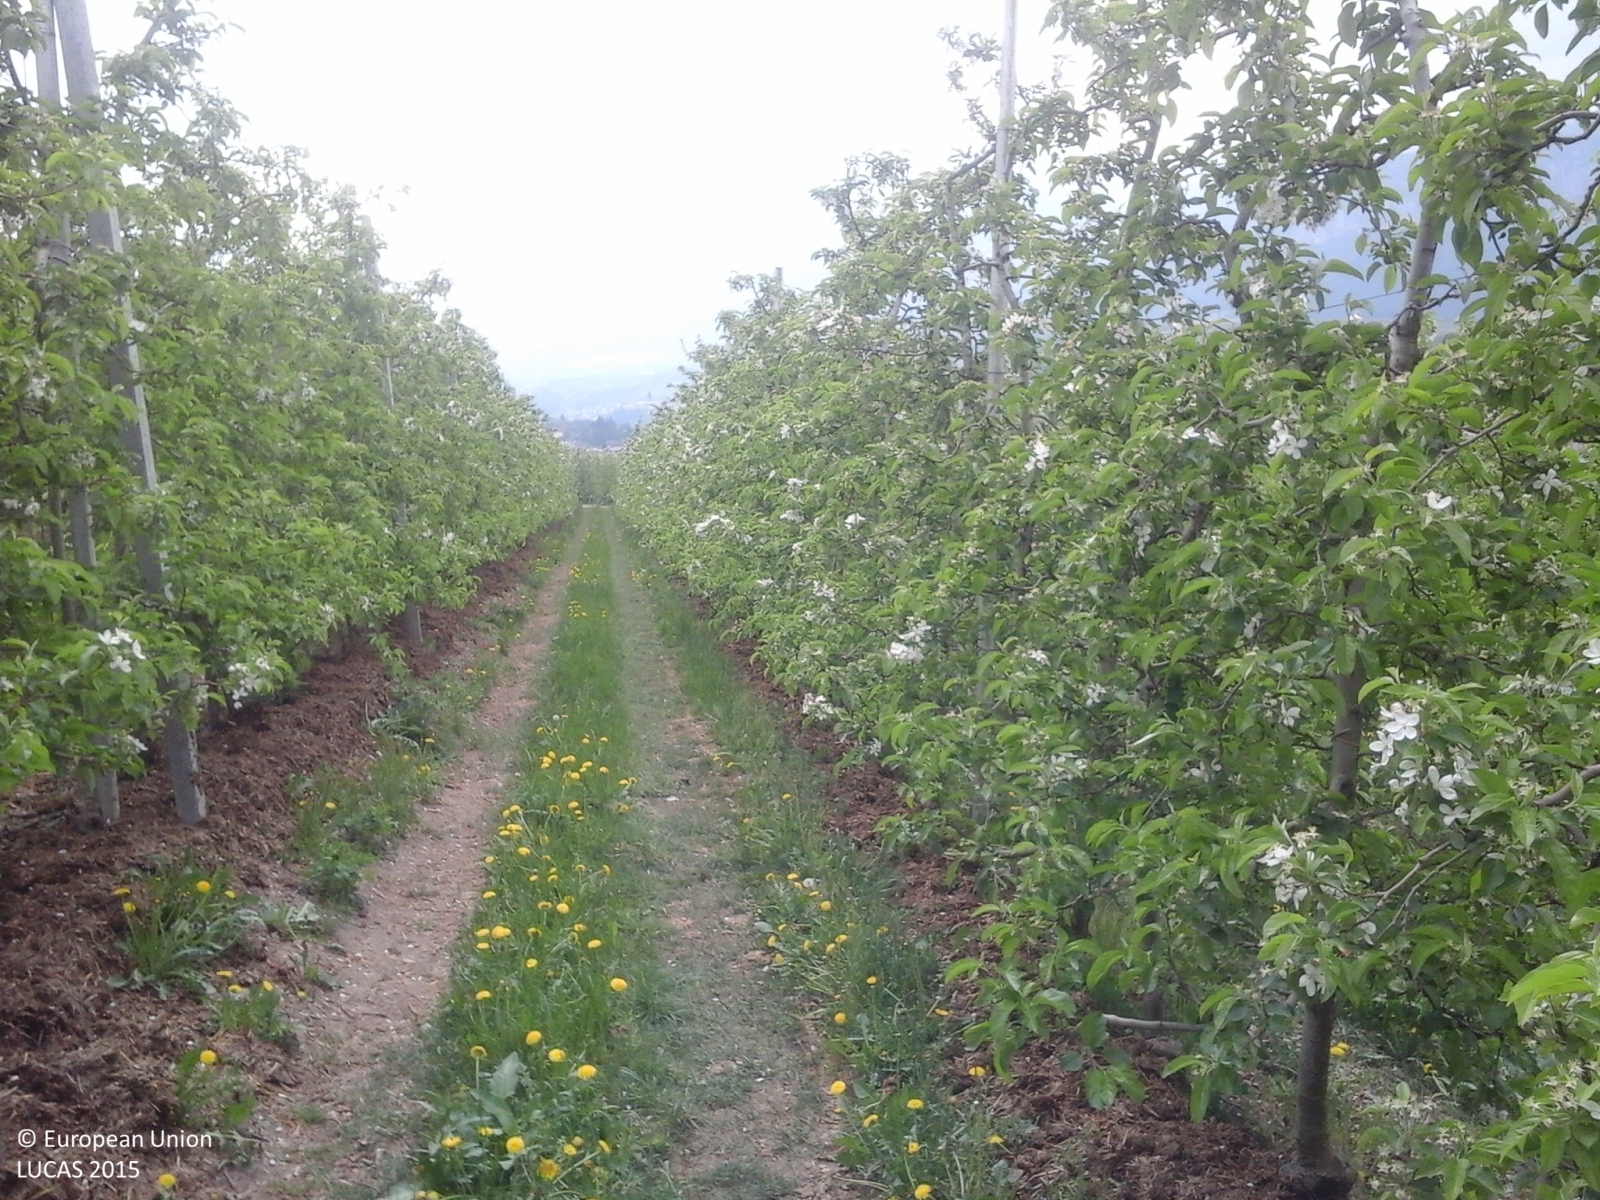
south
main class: Cropland
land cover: Apple fruit
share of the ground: 25 - 50 %
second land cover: Grassland without tree/shrub cover
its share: > 75 %
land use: Agriculture (excluding fallow land and kitchen gardens)
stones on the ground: < 10 %
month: April
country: IT
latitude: 46.3098
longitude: 11.0763
